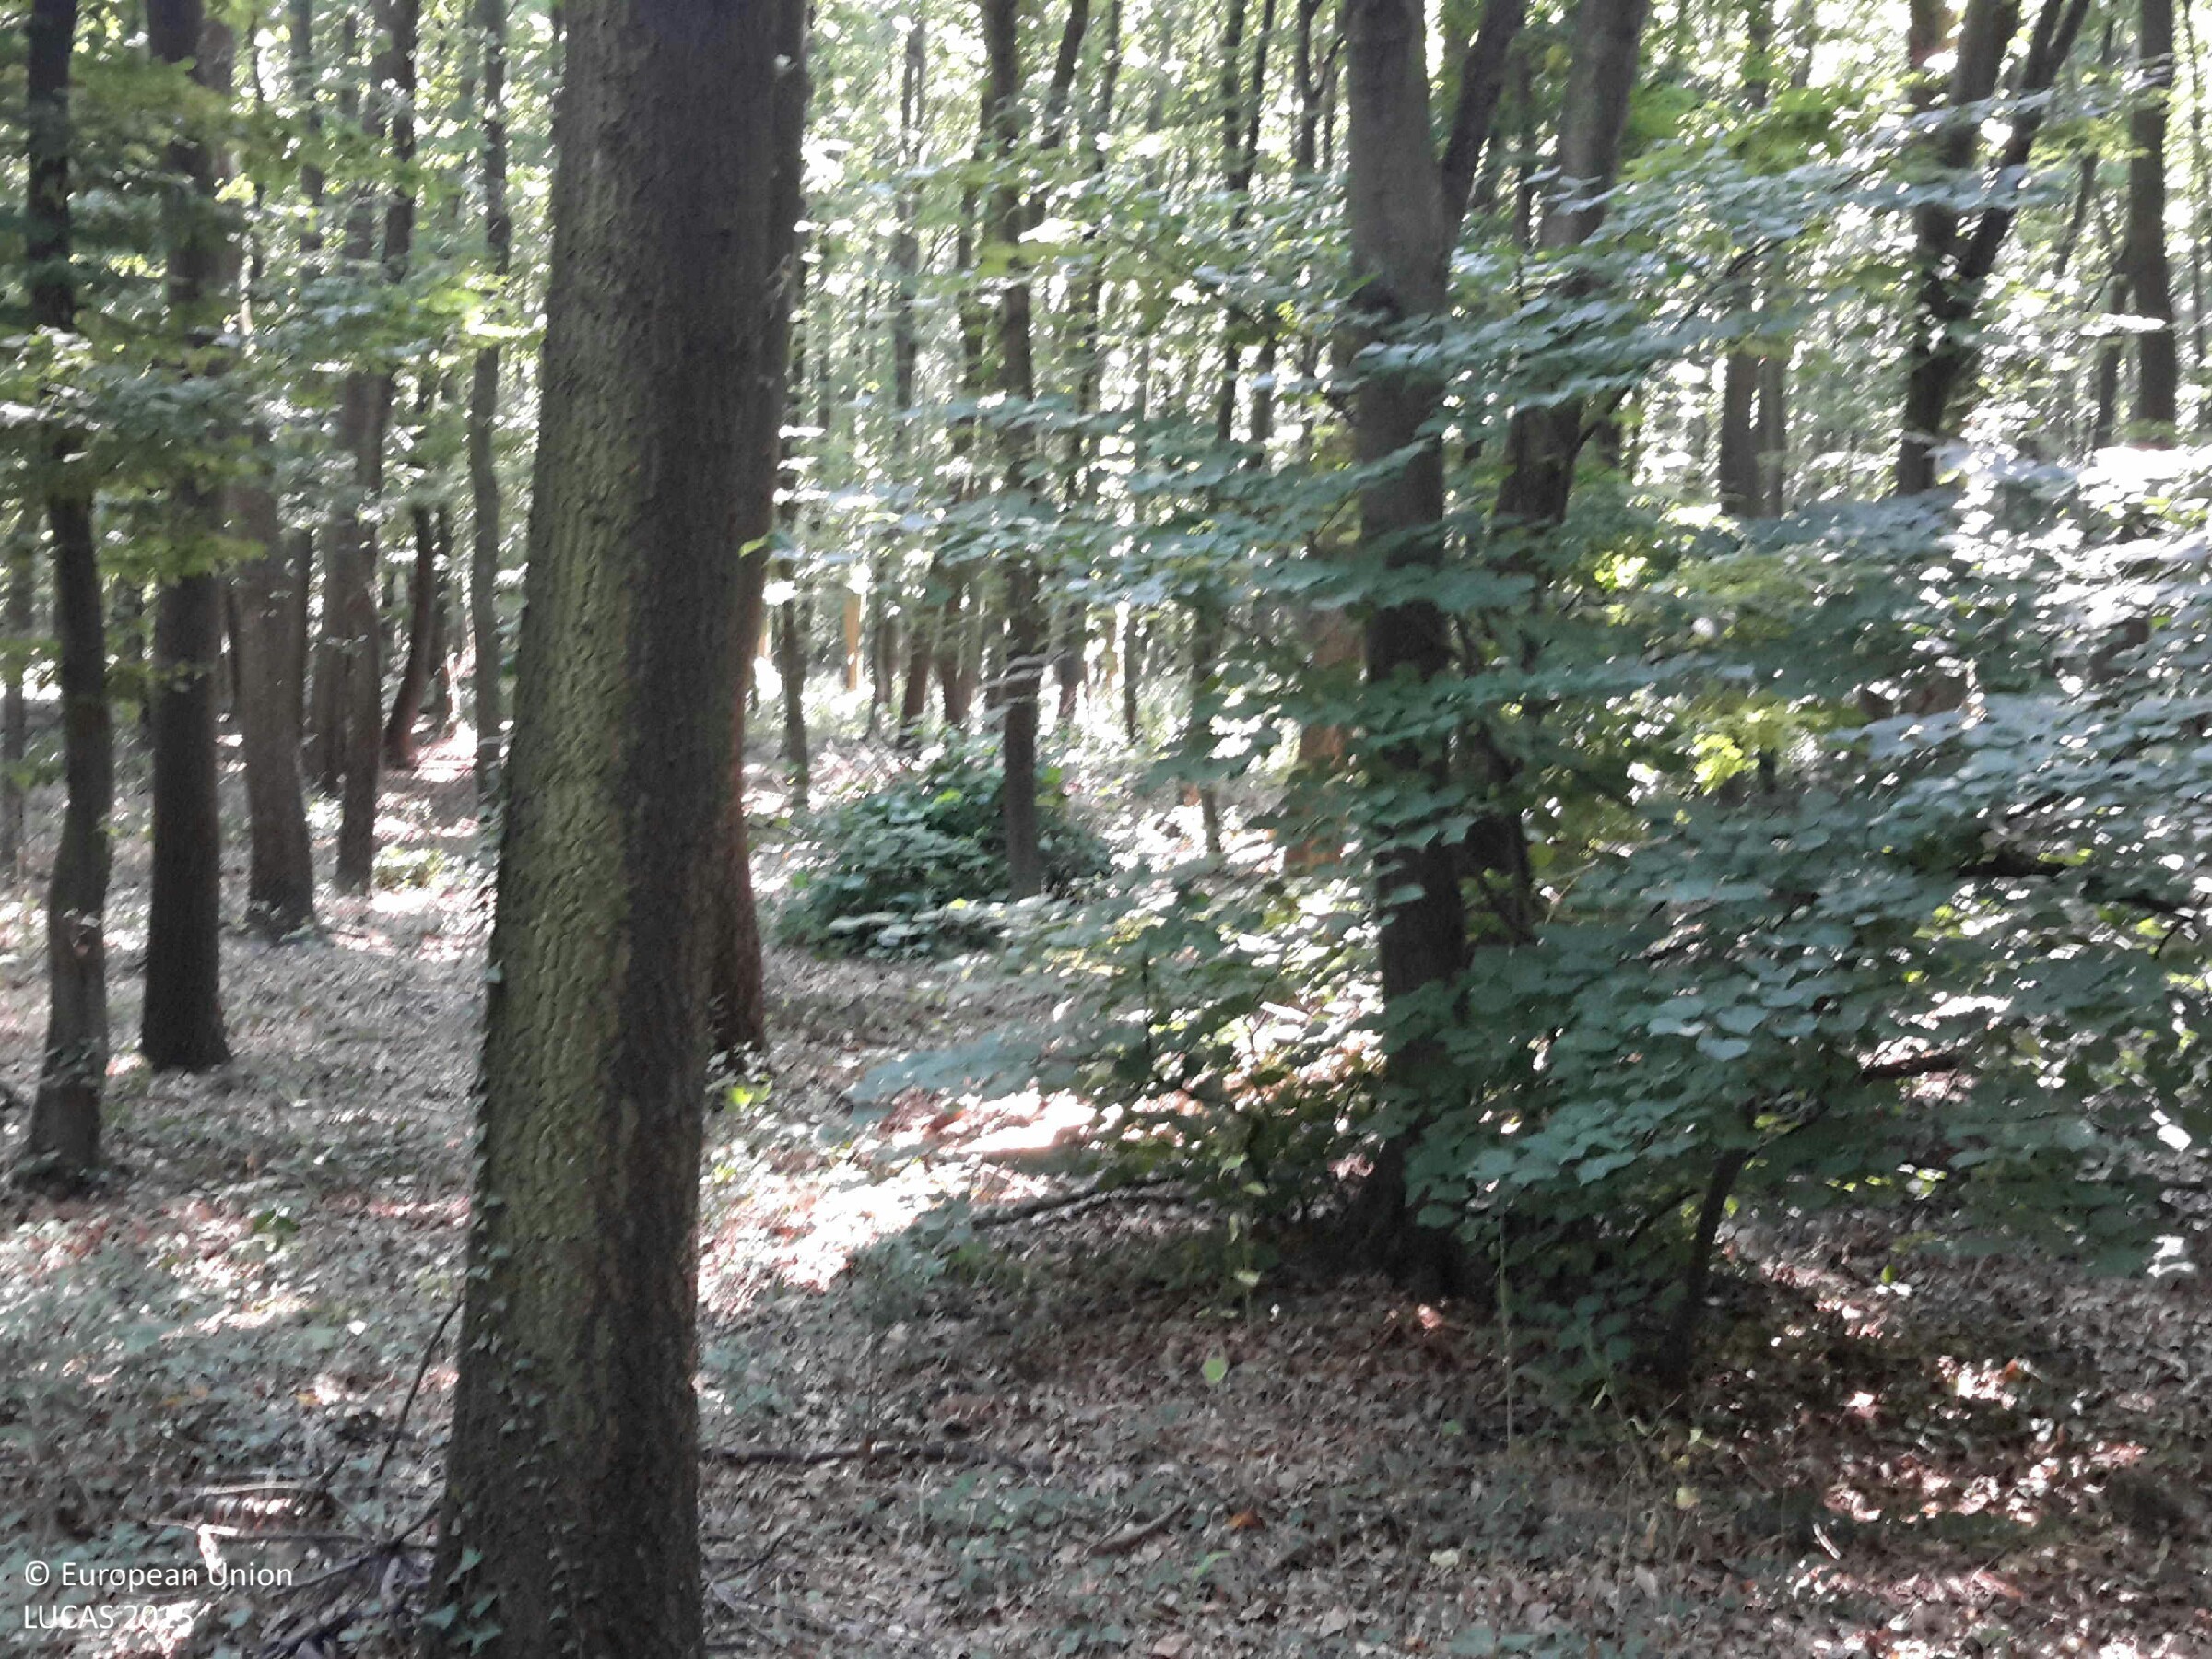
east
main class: Woodland
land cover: Broadleaved woodland
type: mesophytic deciduous forest
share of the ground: > 75 %
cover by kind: broadleaved forest trees 80 %, shrubs 10 %, herbaceous plants 10 %
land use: Forestry
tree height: > 5 m
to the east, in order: Broadleaved woodland
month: June
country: HU
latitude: 47.2308
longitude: 17.4431
